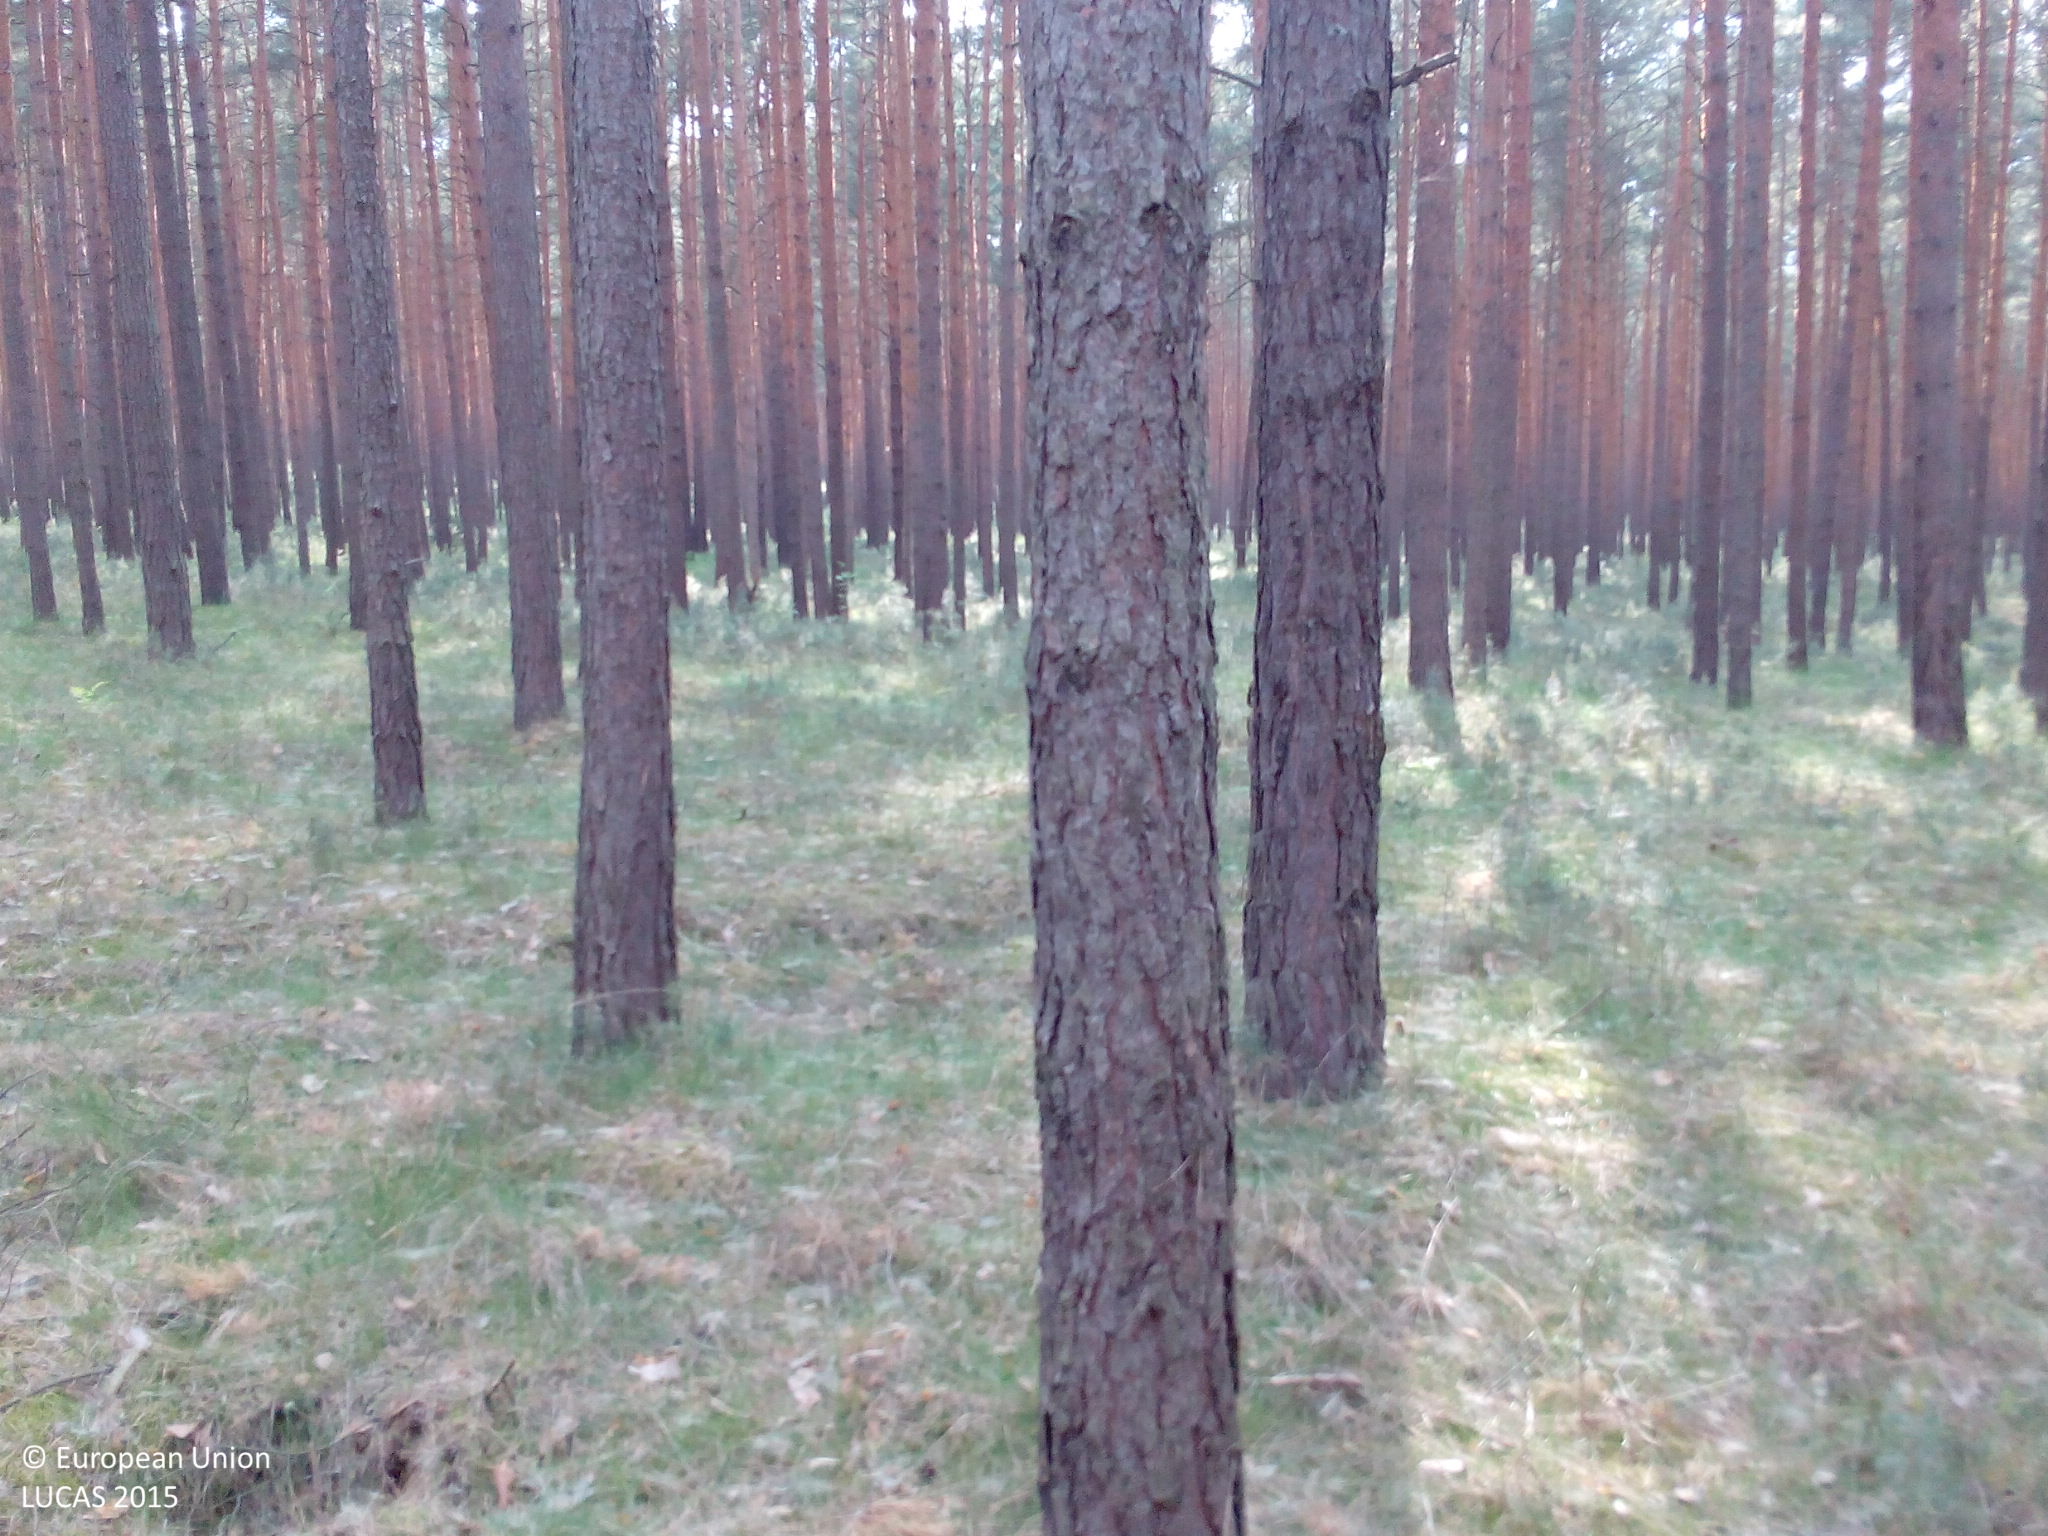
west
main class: Woodland
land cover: Pine dominated coniferous woodland
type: hemiboreal forest and nemoral coniferous forest and mixed broadleaved-coniferous forest
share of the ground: > 75 %
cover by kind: coniferous forest trees 75 %, herbaceous plants 15 %, lichens and mosses 10 %
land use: Forestry
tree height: > 5 m
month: May
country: DE
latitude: 52.1560
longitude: 13.1426
